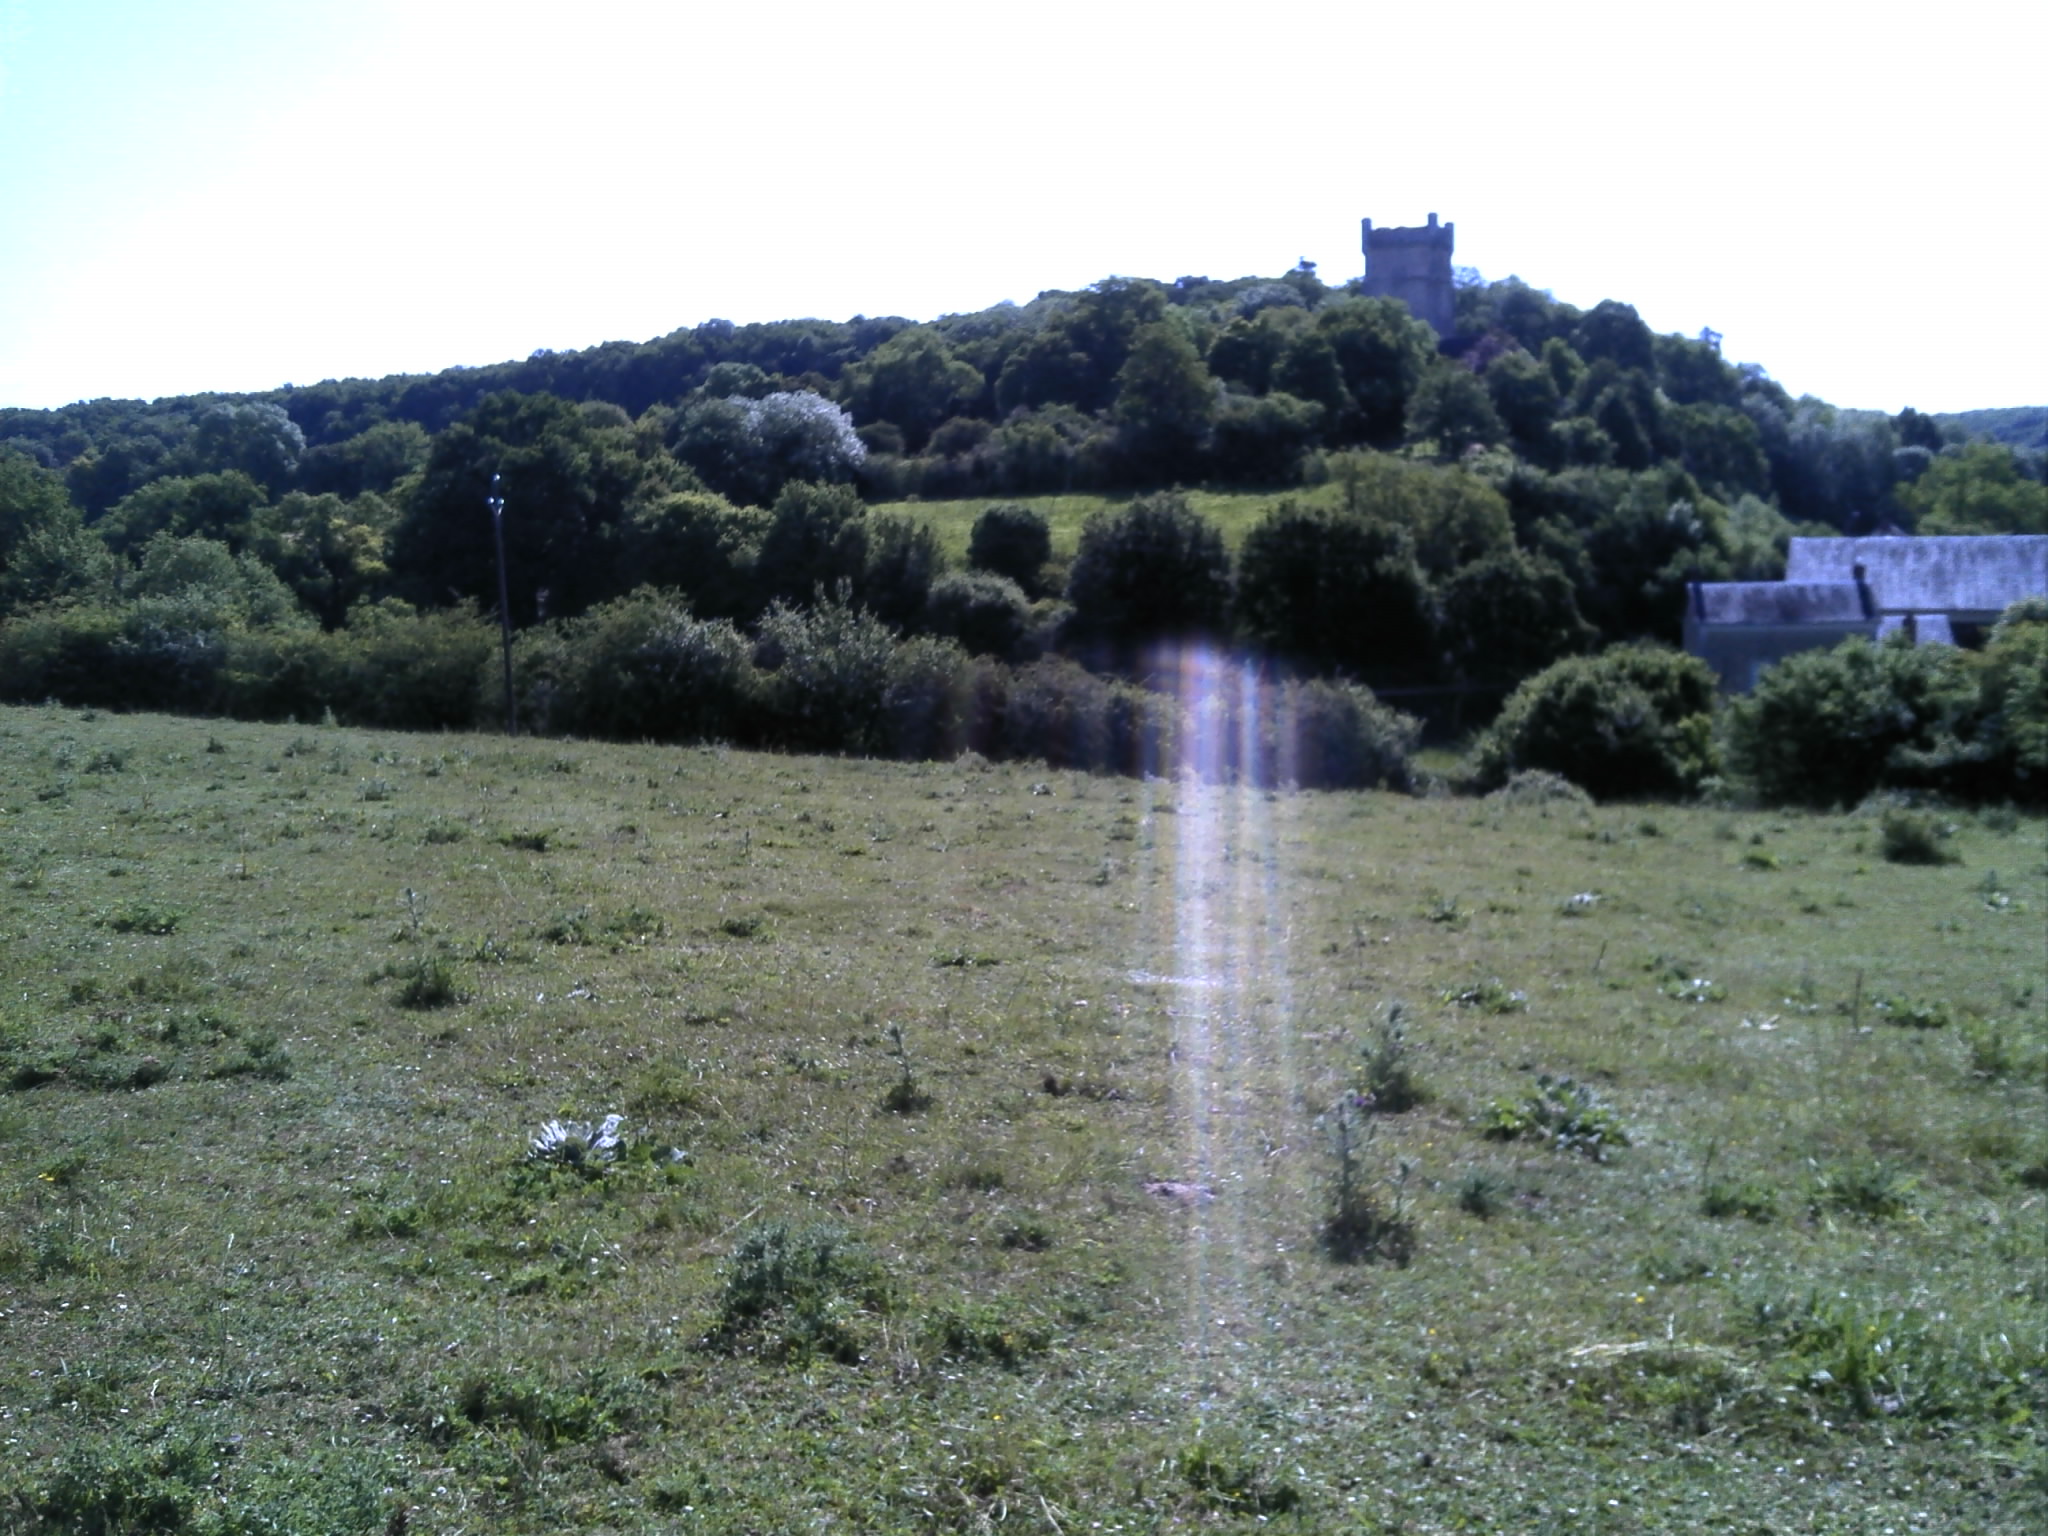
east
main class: Grassland
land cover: Grassland without tree/shrub cover
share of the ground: > 75 %
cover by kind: herbaceous plants 100 %
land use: Agriculture (excluding fallow land and kitchen gardens)
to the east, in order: Grassland without tree/shrub cover; Electric lines; Fences; Managed hedges; Ditches and canals; Grass margins; Paved roads, cycling and walking lanes; Grass margins; Ditches and canals; Fences; Grassland without tree/shrub cover; Fences; Managed hedges; Tracks; Fences; Abandoned hedges; Grassland without tree/shrub cover; Managed hedges; Tracks; Abandoned hedges; Fences; Grassland without tree/shrub cover; Broadleaved woodland; Grassland without tree/shrub cover
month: May
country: FR
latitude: 46.6331
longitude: 1.5645
